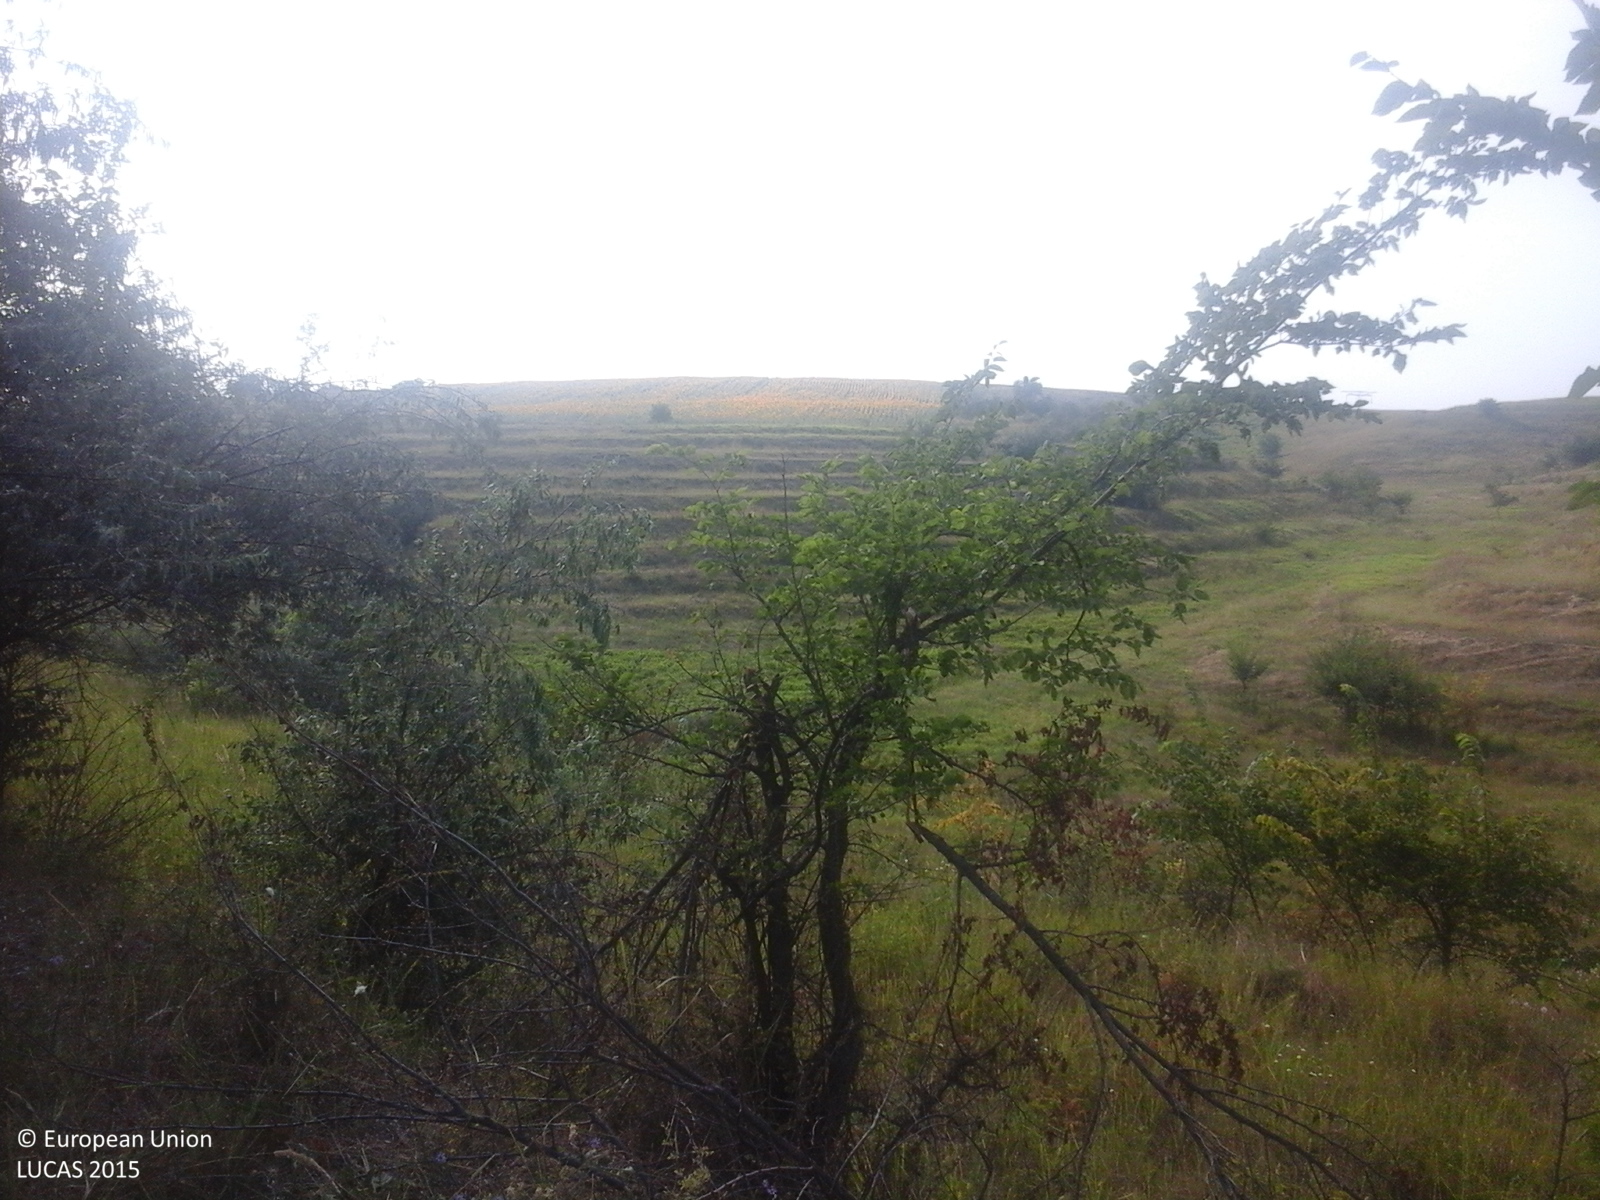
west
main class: Grassland
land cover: Grassland with sparse tree/shrub cover
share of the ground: > 75 %
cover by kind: herbaceous plants 85 %, shrubs 10 %, broadleaved forest trees 5 %
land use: Agriculture (excluding fallow land and kitchen gardens)
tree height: < 5 m
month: July
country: RO
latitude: 45.2647
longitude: 28.3384
